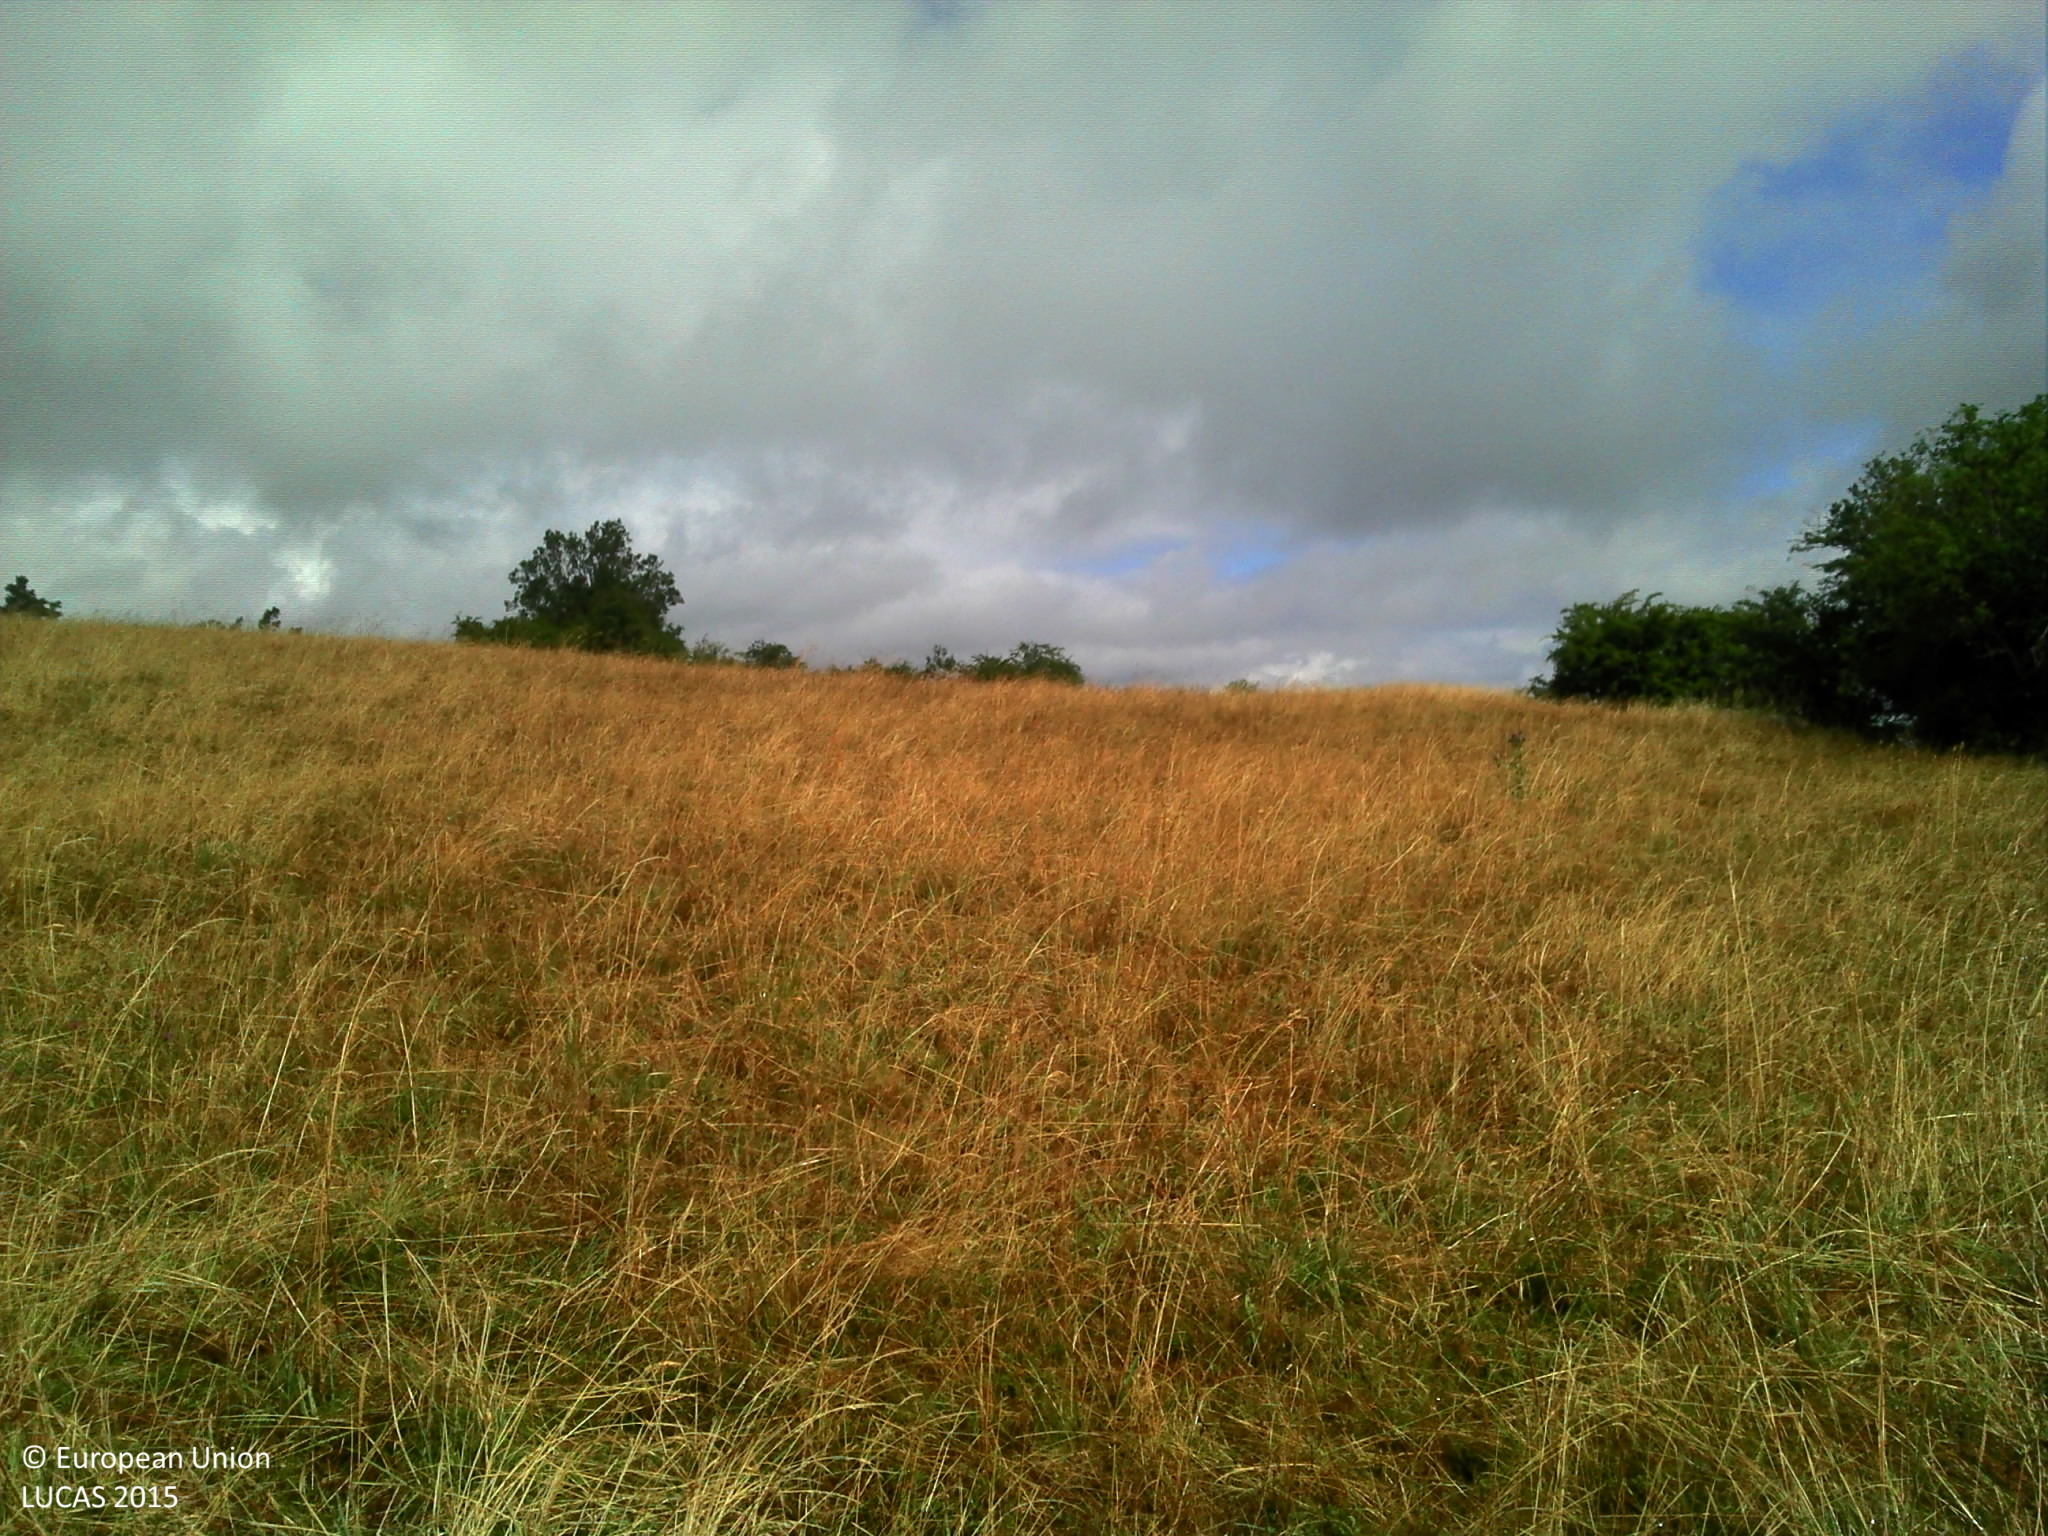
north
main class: Grassland
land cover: Grassland without tree/shrub cover
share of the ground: > 75 %
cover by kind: herbaceous plants 100 %
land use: Agriculture (excluding fallow land and kitchen gardens)
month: July
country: FR
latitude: 44.9408
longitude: 2.9180
